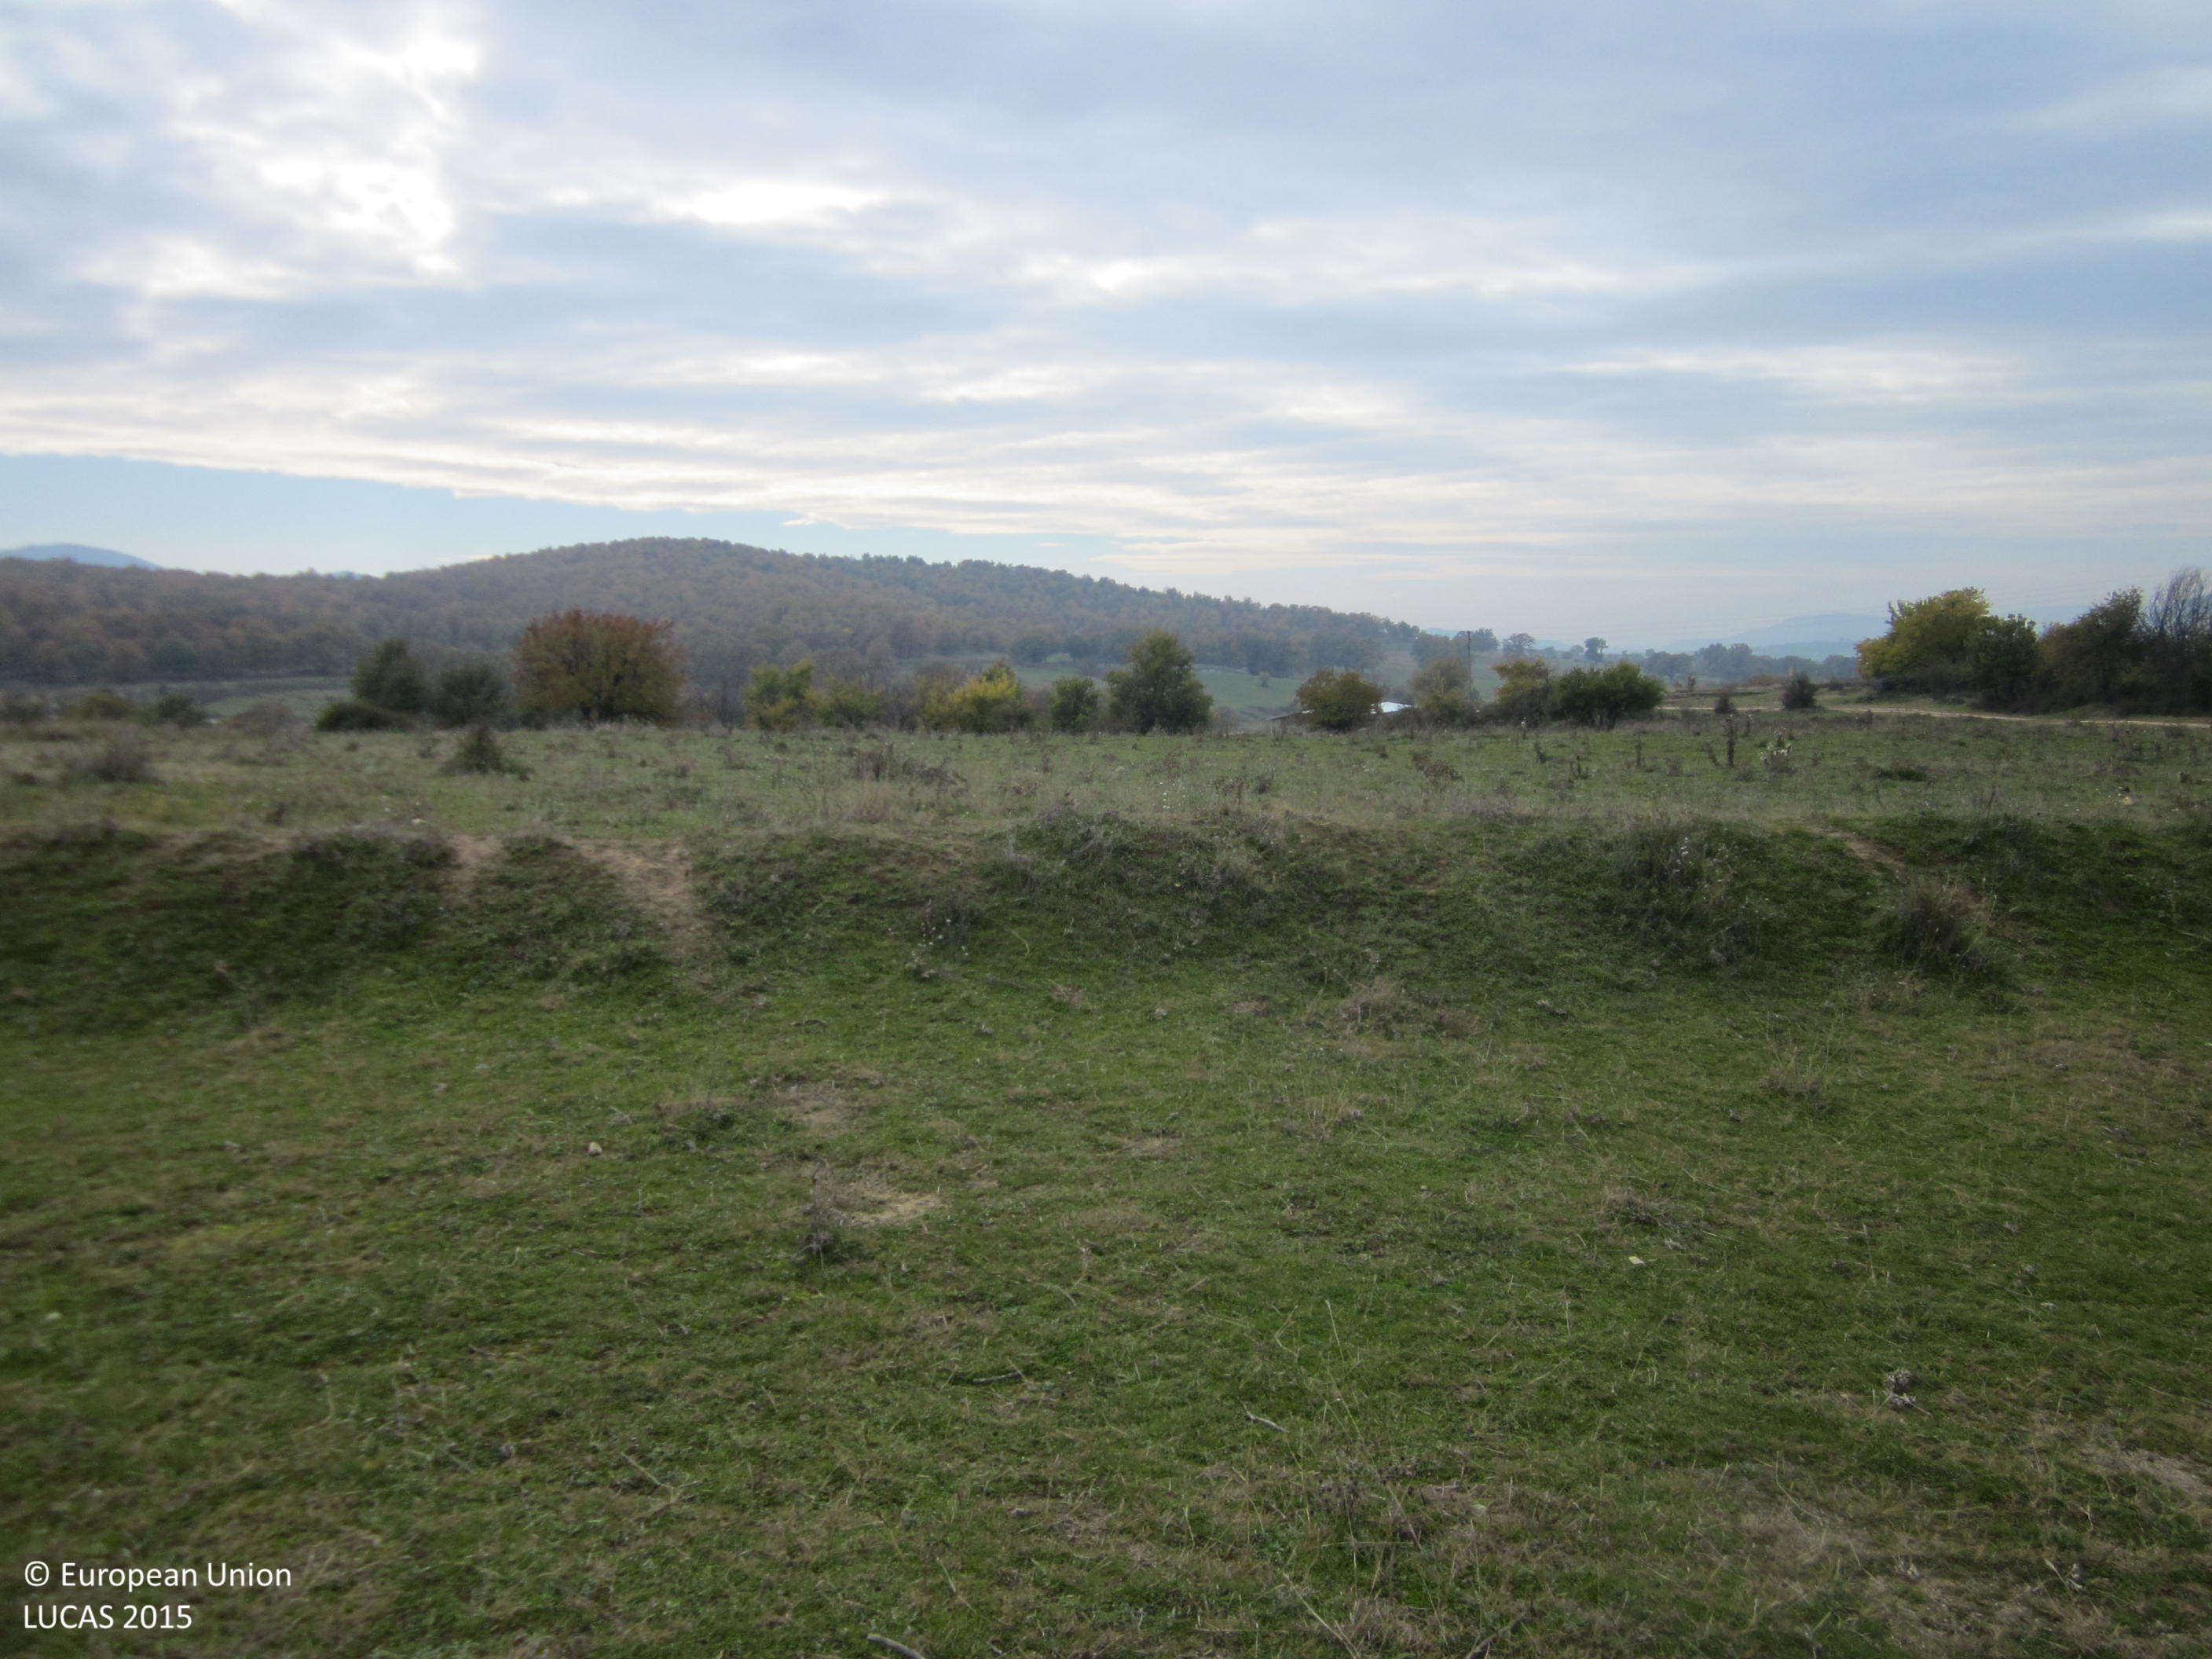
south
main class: Grassland
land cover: Grassland without tree/shrub cover
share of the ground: > 75 %
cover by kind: herbaceous plants 100 %
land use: Agriculture (excluding fallow land and kitchen gardens)
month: November
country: BG
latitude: 42.5700
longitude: 24.9093
